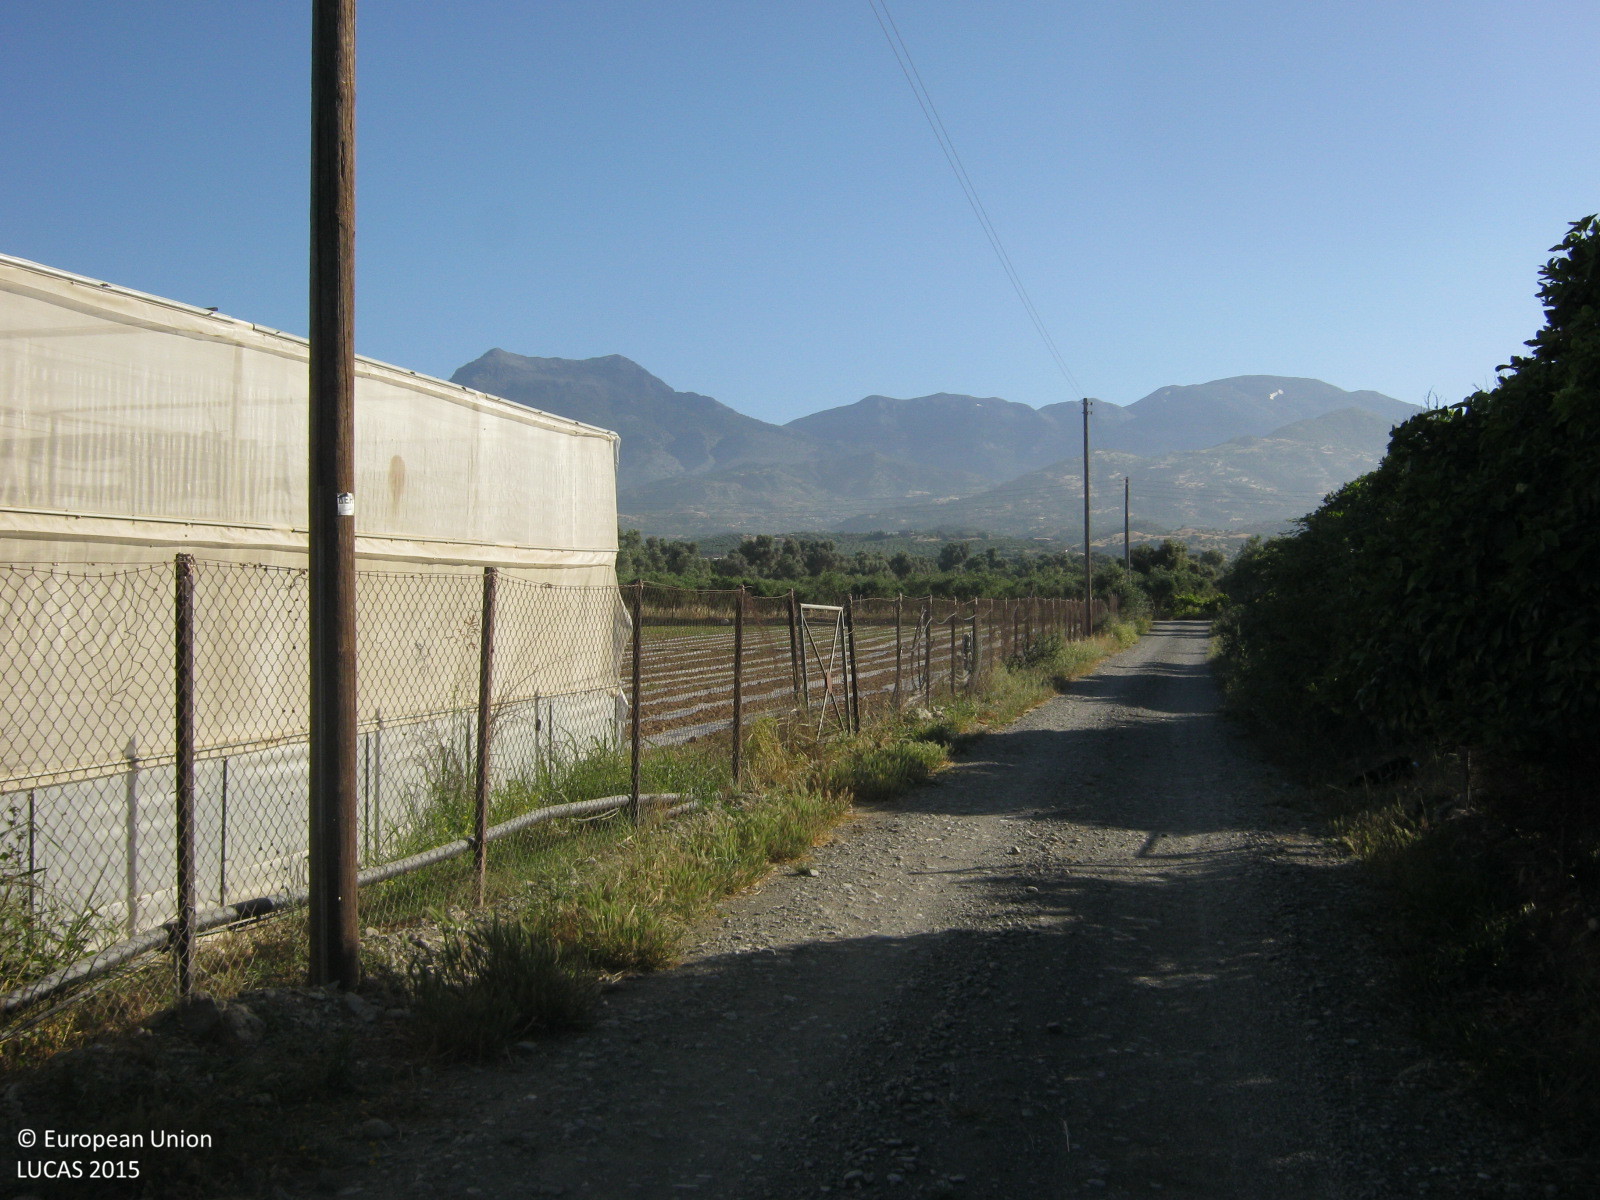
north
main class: Cropland
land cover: Permanent crops (only in case pi)
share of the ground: > 75 %
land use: Agriculture (excluding fallow land and kitchen gardens)
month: May
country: GR
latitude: 35.0721
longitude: 24.8000
